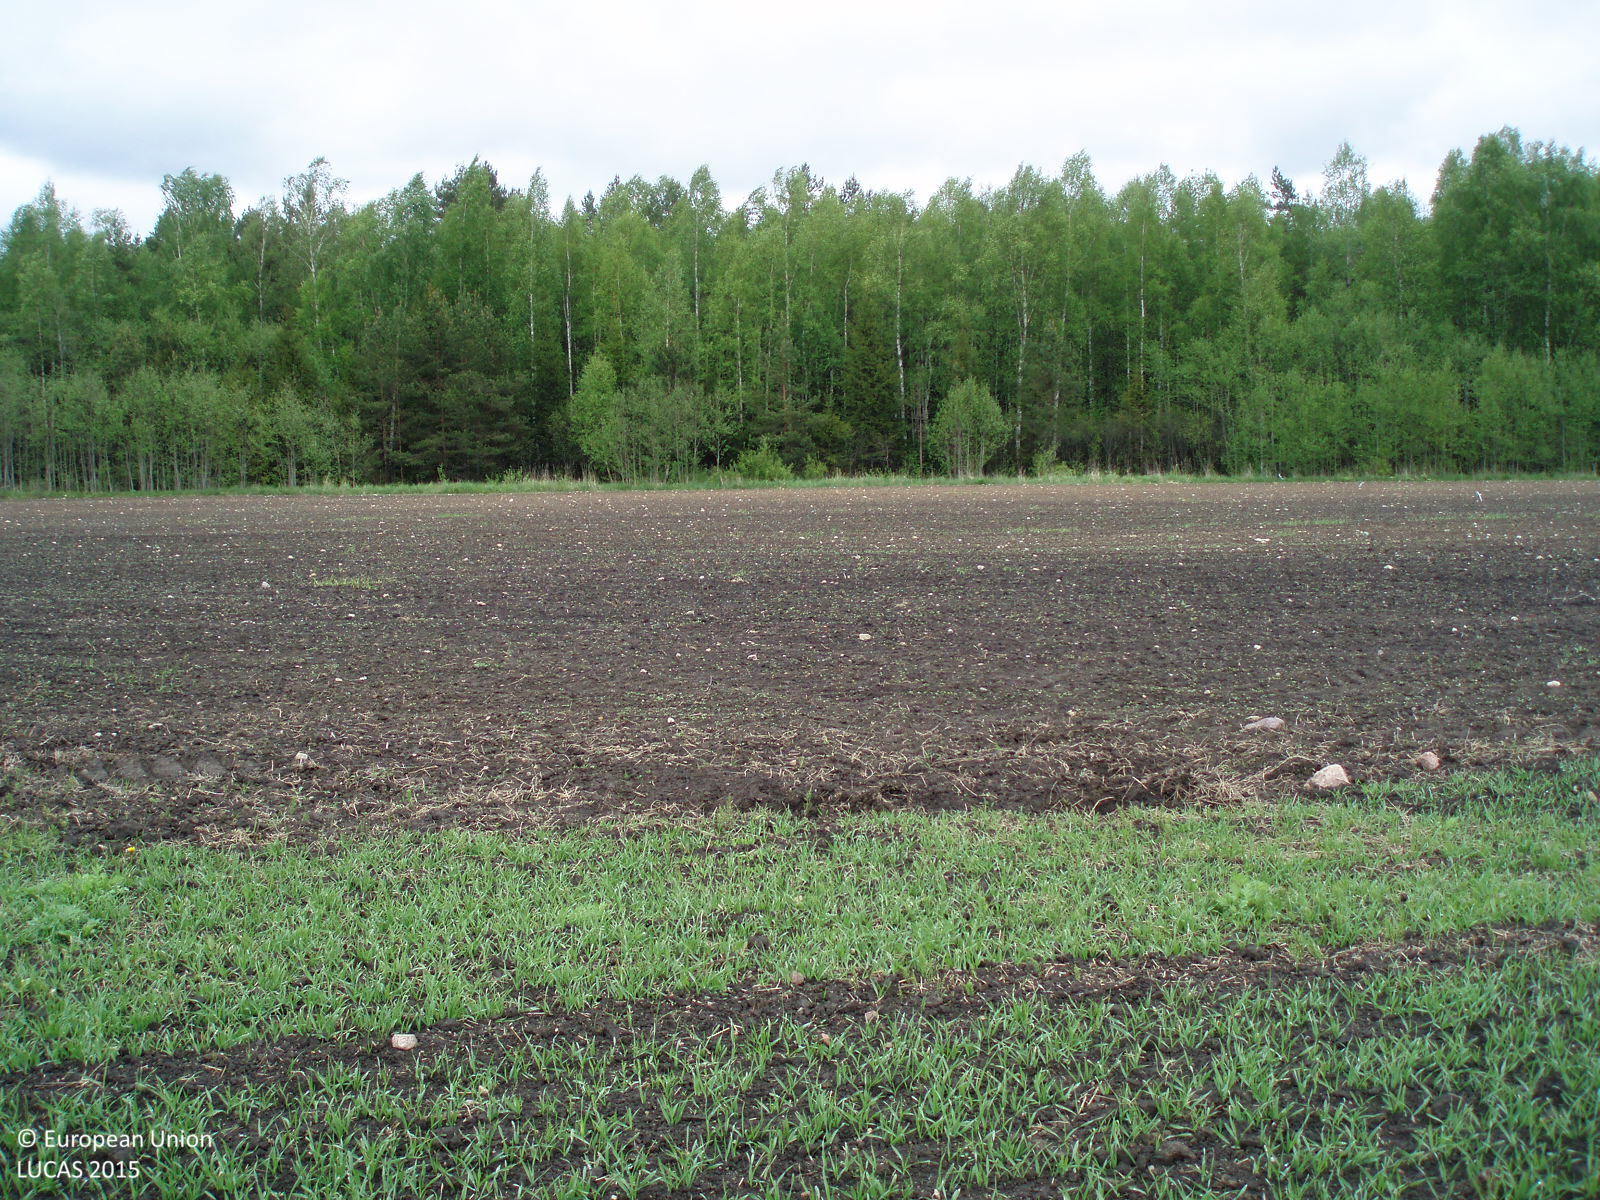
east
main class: Cropland
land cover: Barley
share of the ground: 50 - 75 %
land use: Agriculture (excluding fallow land and kitchen gardens)
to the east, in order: Barley; Rape and turnip rape; Grassland with sparse tree/shrub cover; Inland fresh running water; Other mixed woodland
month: May
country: LT
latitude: 56.3327
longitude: 22.5616
